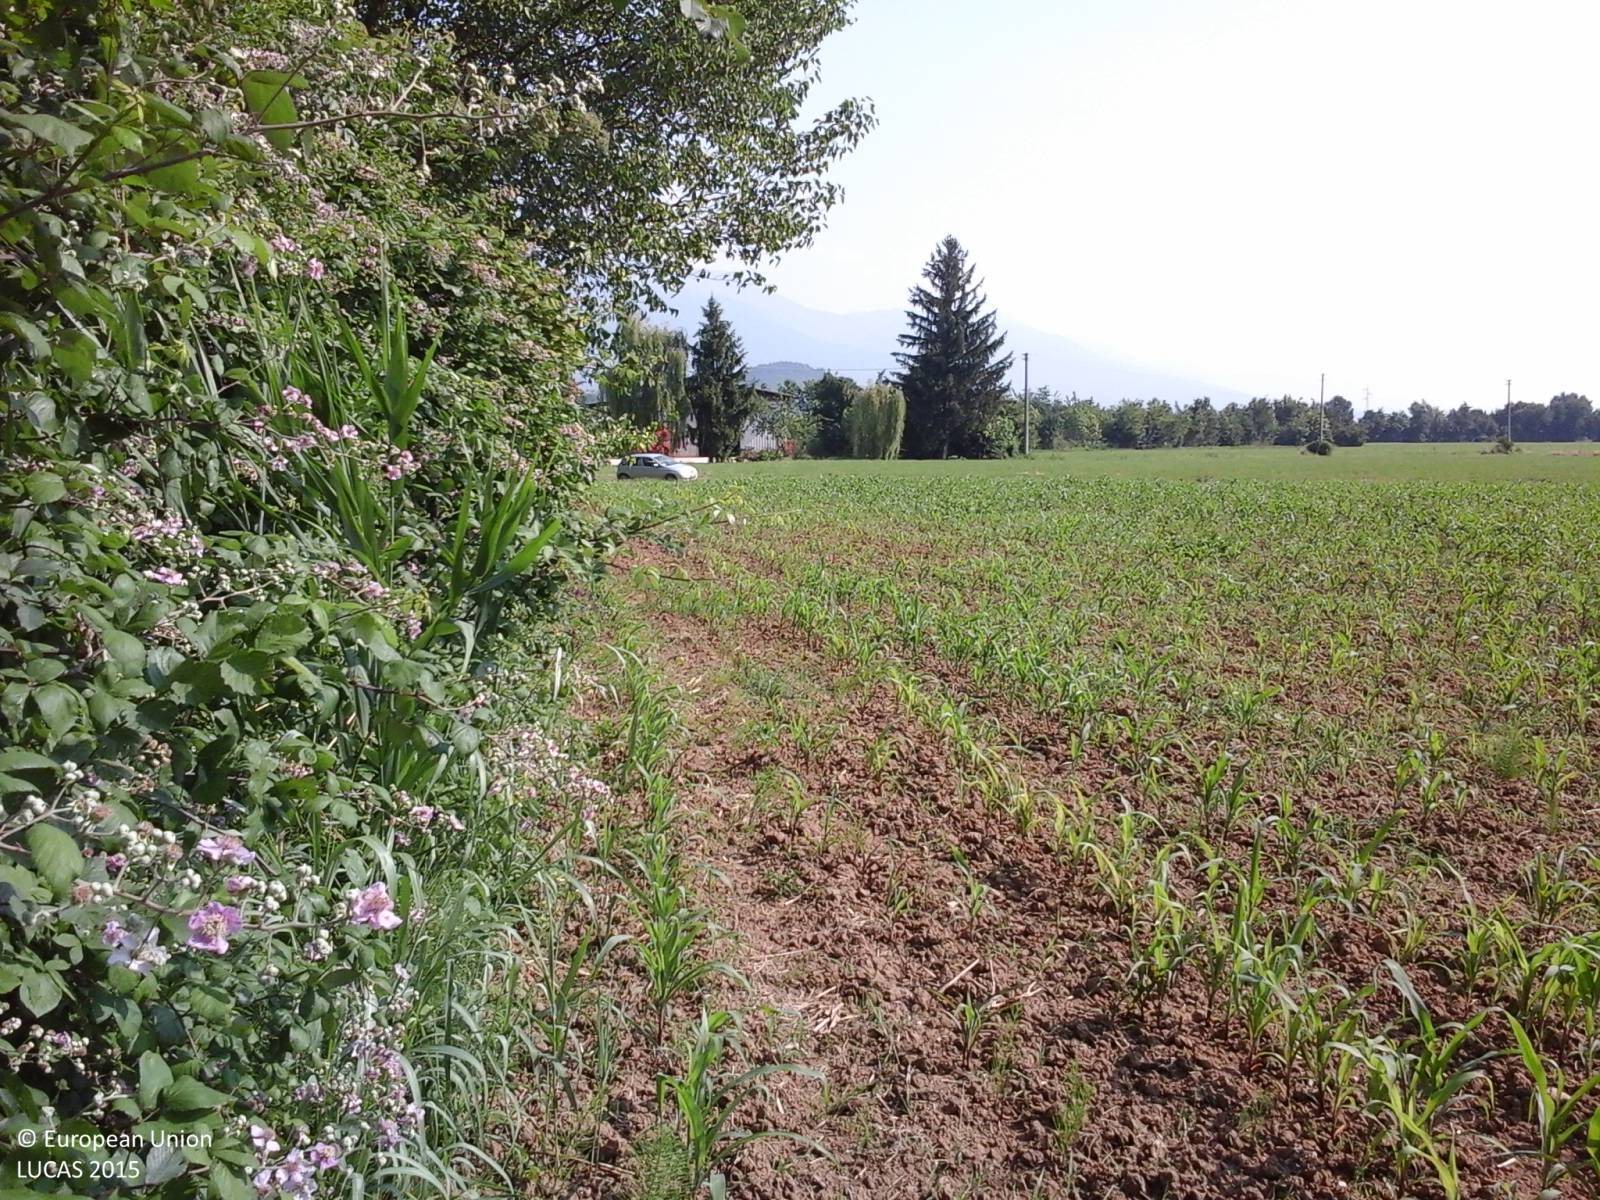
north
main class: Cropland
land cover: Maize
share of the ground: < 10 %
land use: Agriculture (excluding fallow land and kitchen gardens)
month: June
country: IT
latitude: 45.9625
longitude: 12.4614
